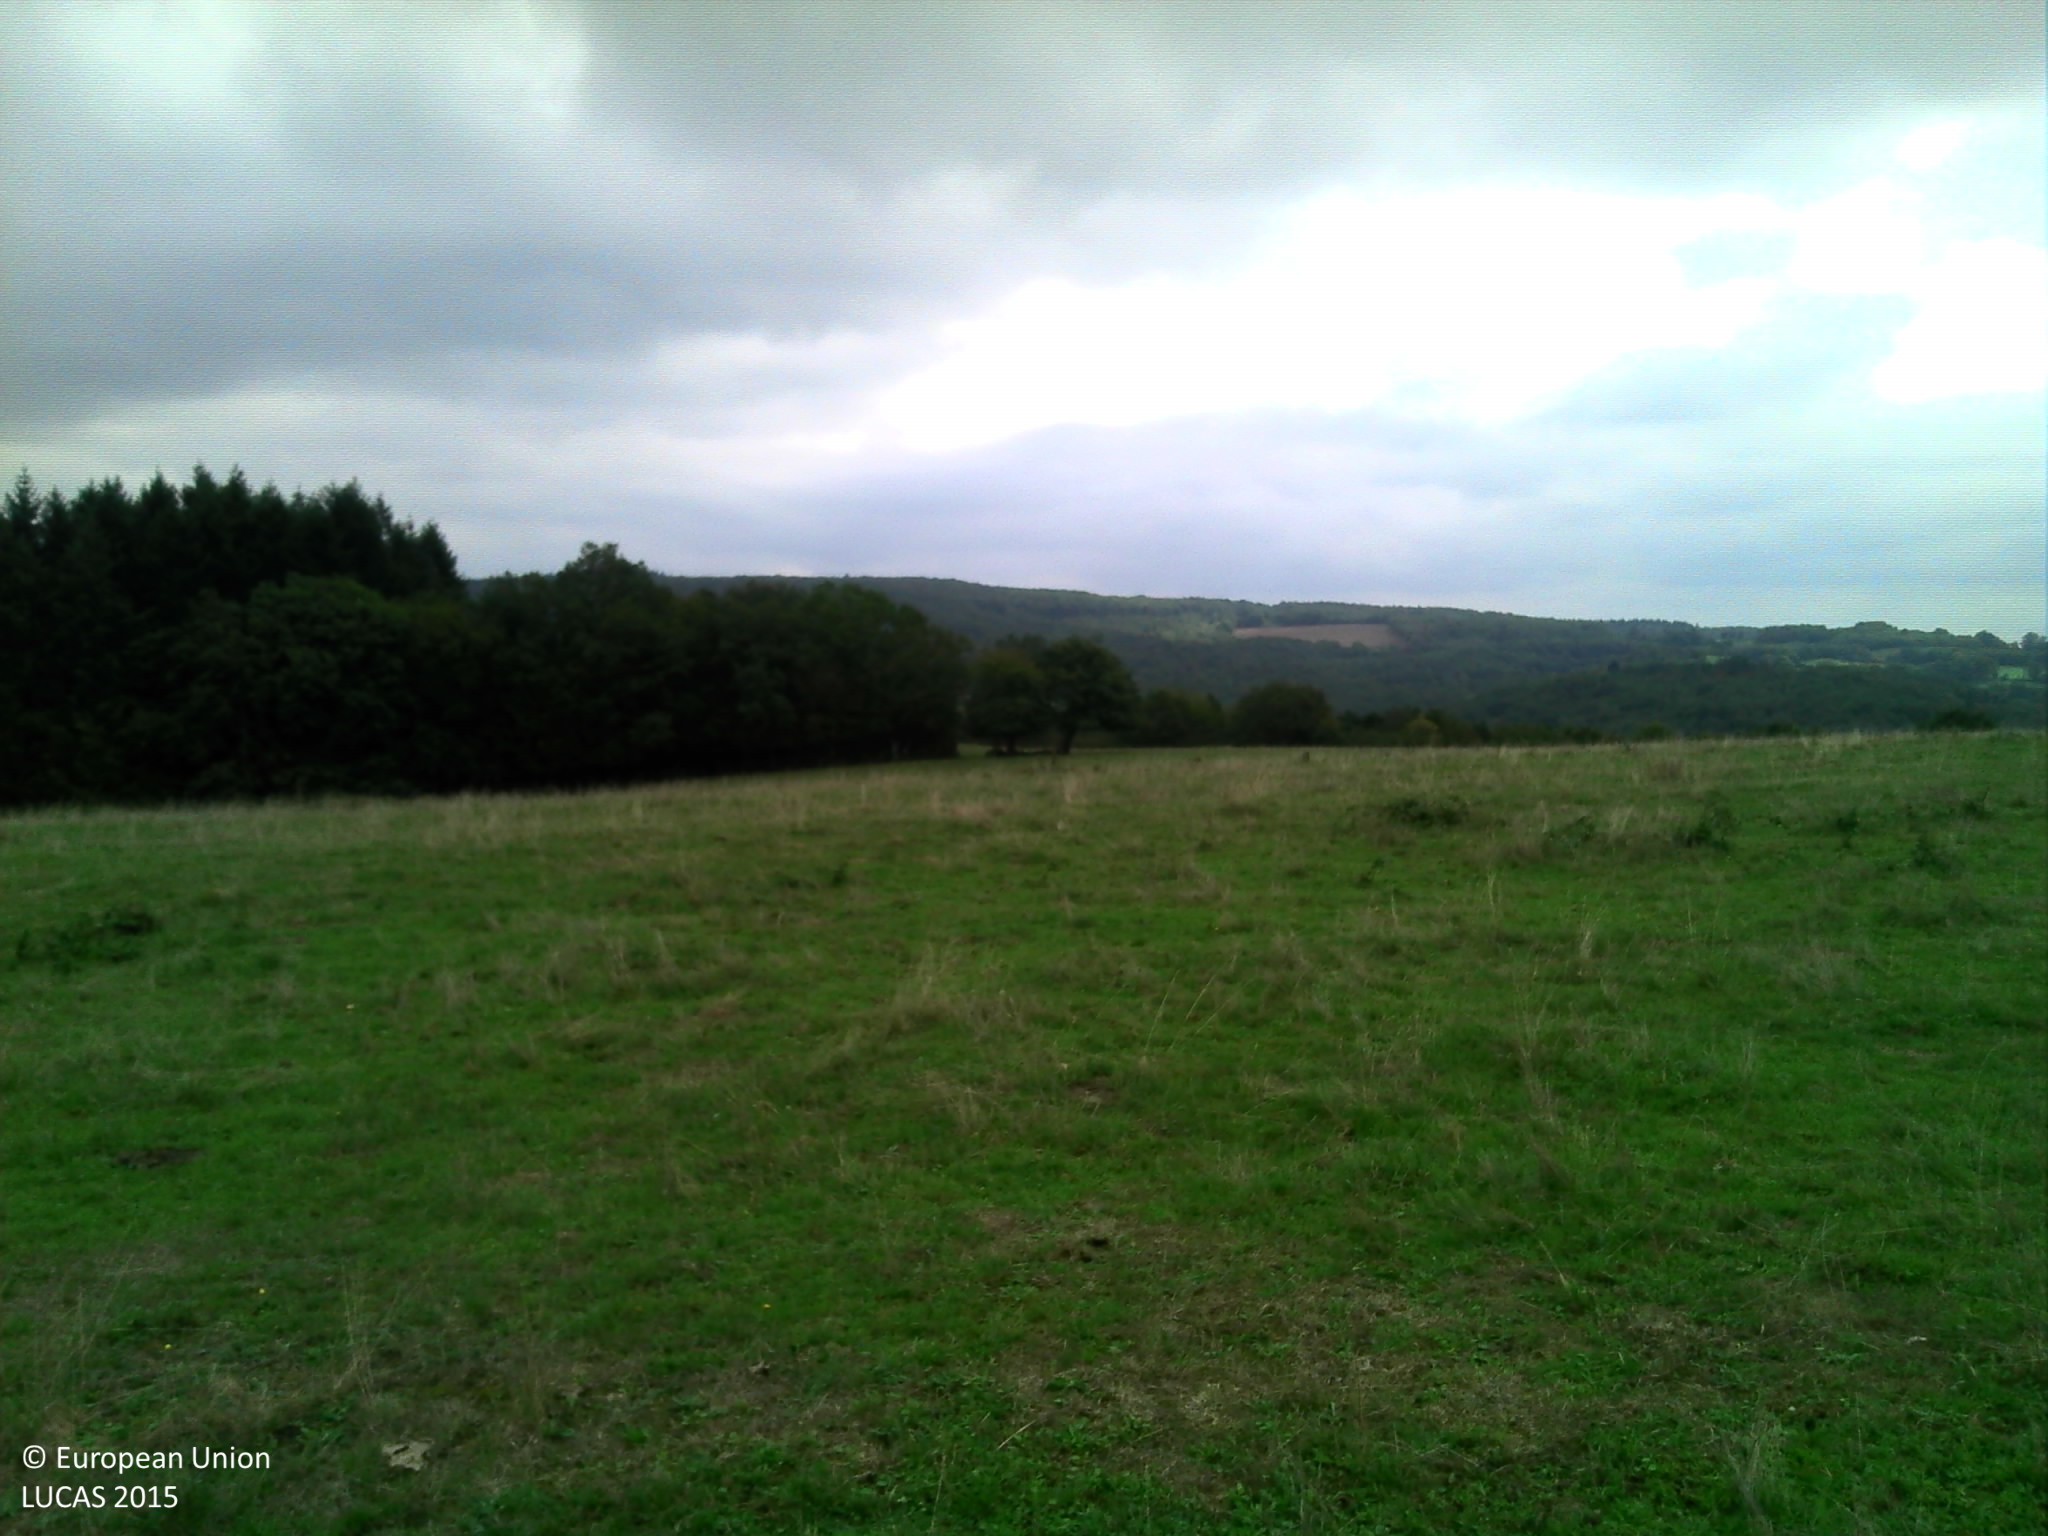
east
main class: Grassland
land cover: Grassland without tree/shrub cover
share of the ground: > 75 %
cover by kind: herbaceous plants 100 %
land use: Agriculture (excluding fallow land and kitchen gardens)
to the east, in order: Grassland without tree/shrub cover; Single bushes/trees; Grassland without tree/shrub cover
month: September
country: FR
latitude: 47.0683
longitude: 4.3507
